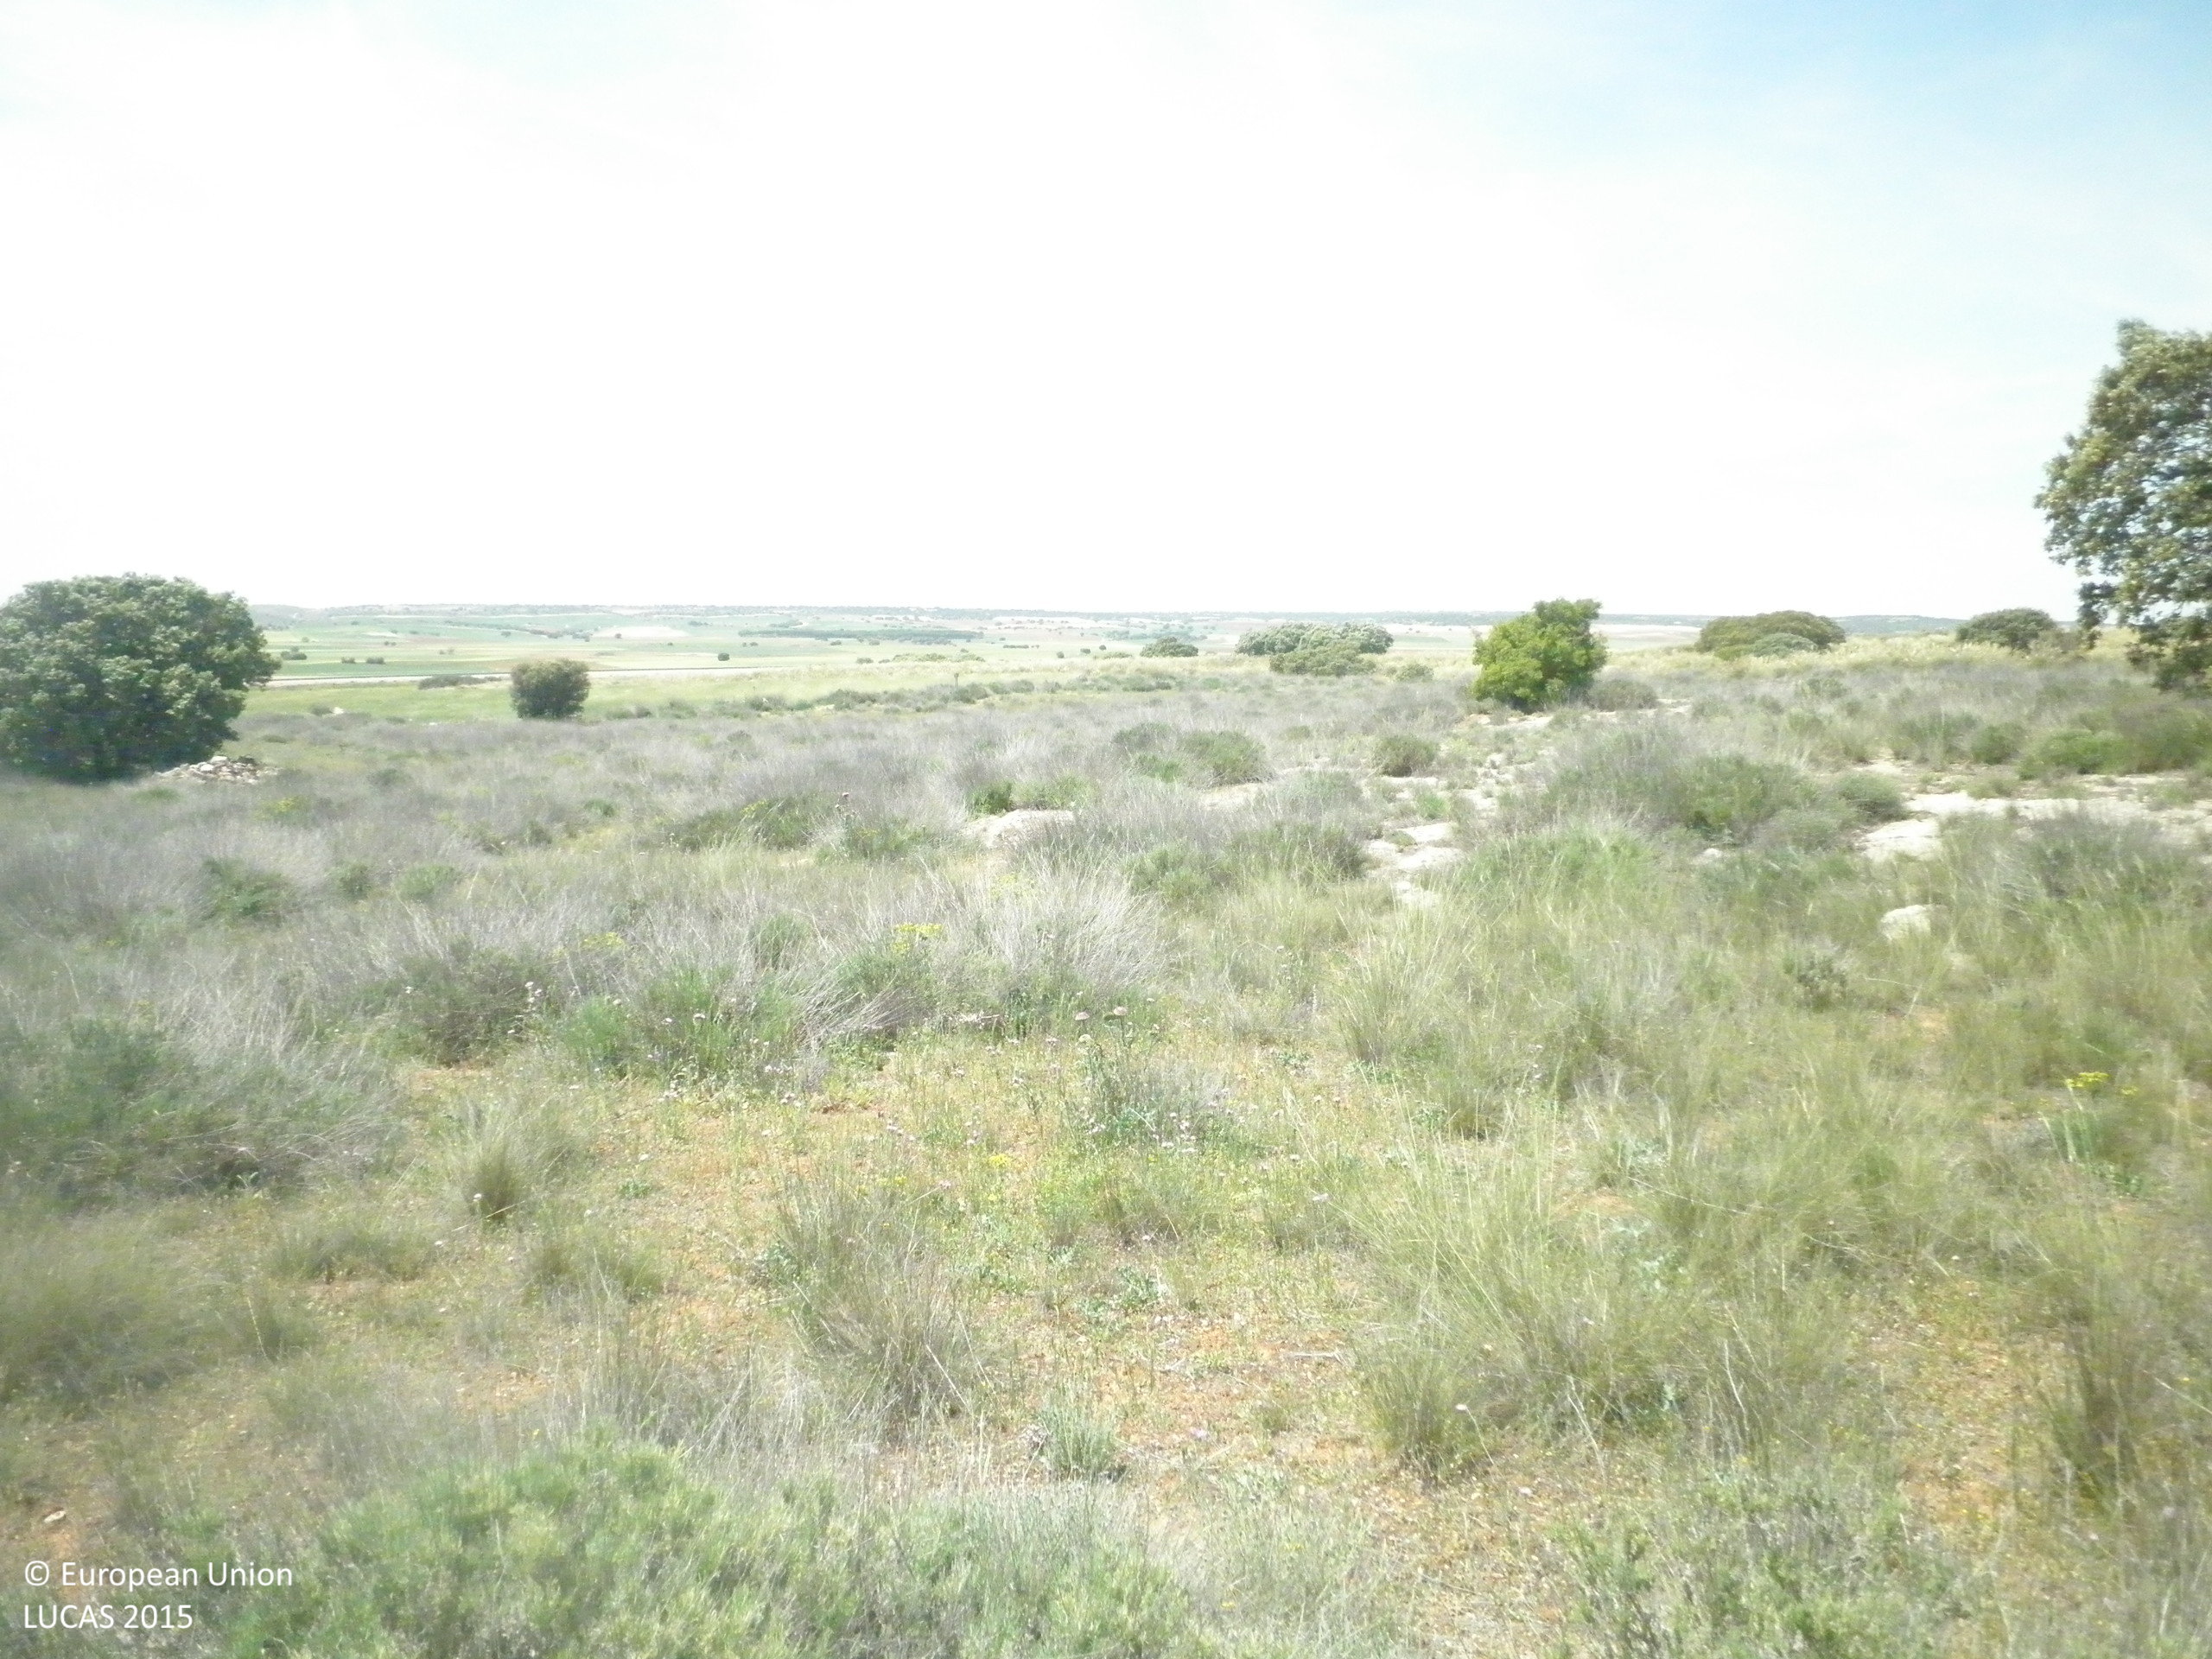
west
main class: Shrubland
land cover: Shrubland without tree cover
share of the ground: 50 - 75 %
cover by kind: unconsolidated bare surface 40 %, shrubs 30 %, herbaceous plants 30 %
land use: Semi-natural and natural areas not in use
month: May
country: ES
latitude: 39.6181
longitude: -2.7245
